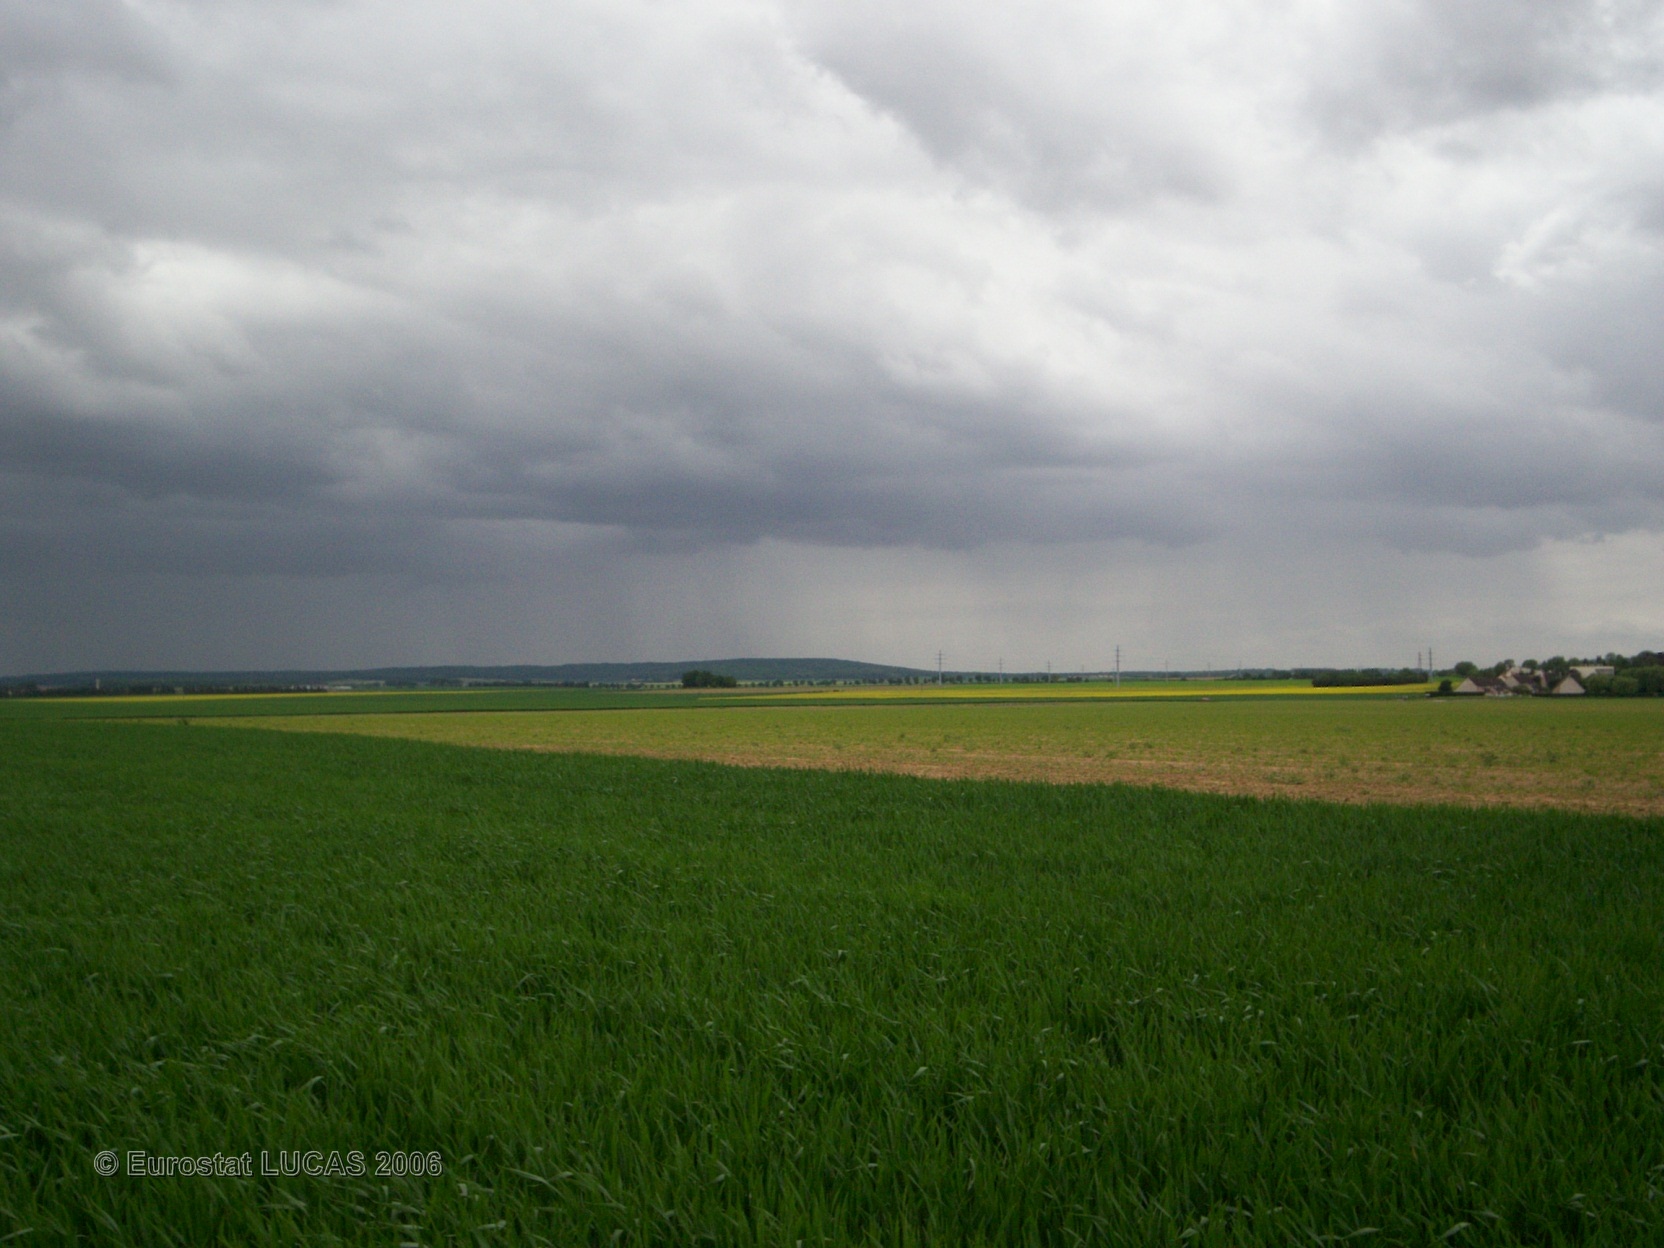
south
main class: Cropland
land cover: Common wheat
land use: Agriculture (excluding fallow land and kitchen gardens)
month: May
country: FR
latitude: 49.1060
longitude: 2.7710
